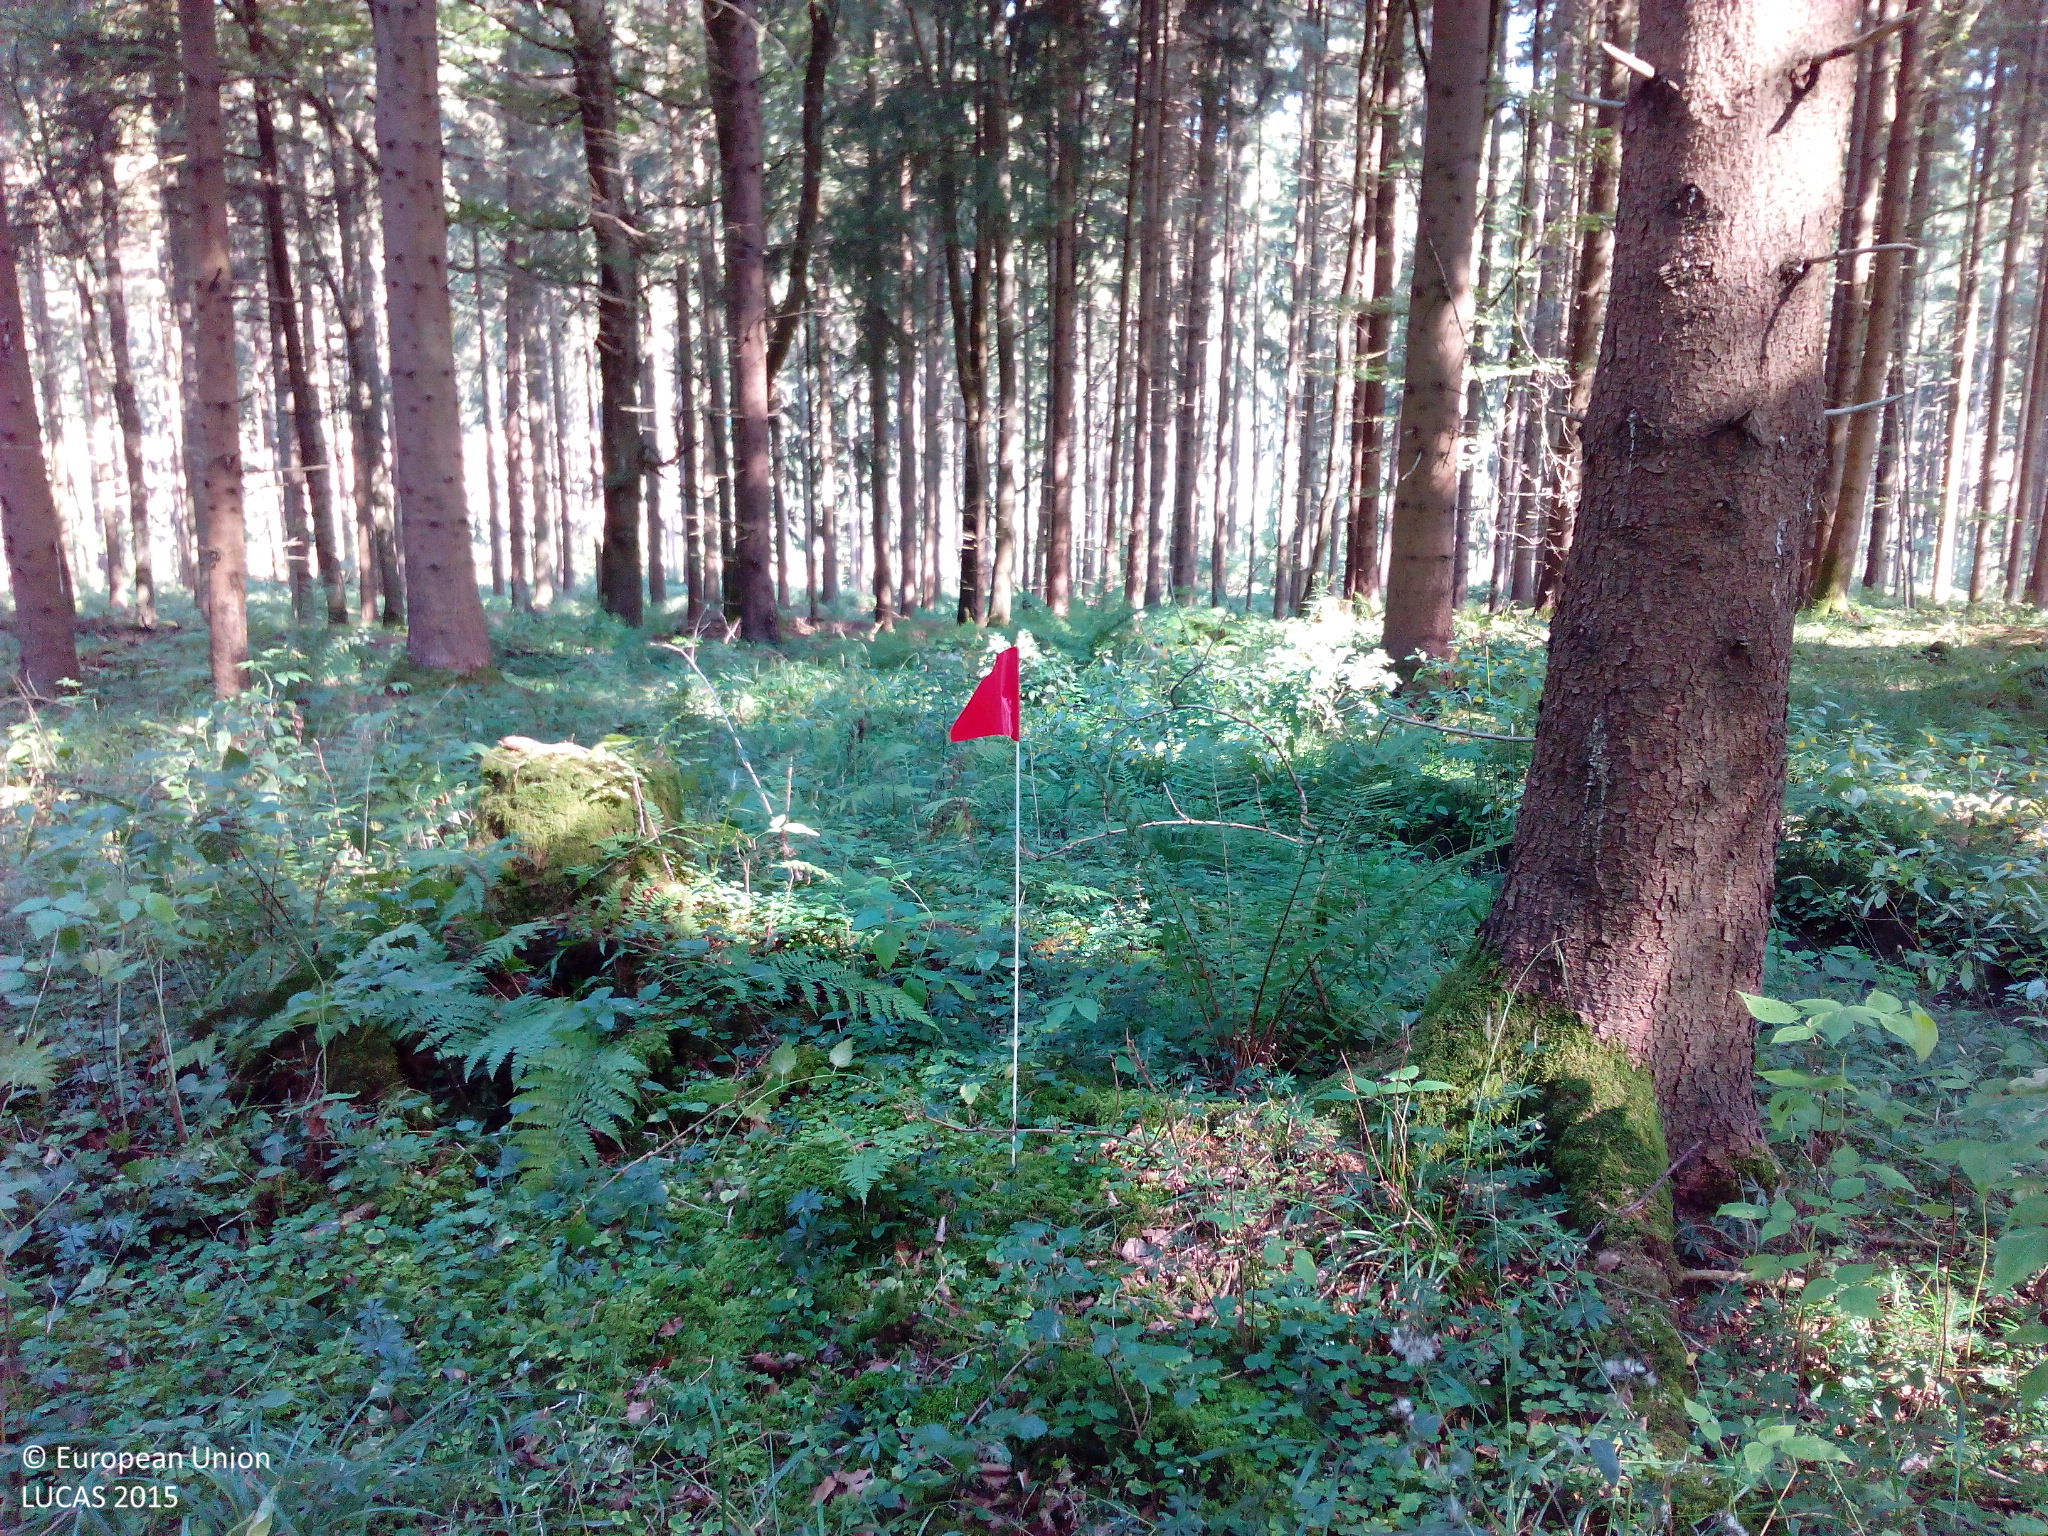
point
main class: Woodland
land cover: Spruce dominated coniferous woodland
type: hemiboreal forest and nemoral coniferous forest and mixed broadleaved-coniferous forest
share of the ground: 50 - 75 %
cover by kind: coniferous forest trees 55 %, herbaceous plants 20 %, lichens and mosses 10 %, broadleaved forest trees 5 %, shrubs 5 %, unconsolidated bare surface 5 %
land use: Forestry
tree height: > 5 m
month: September
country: DE
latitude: 48.1785
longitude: 8.5887
